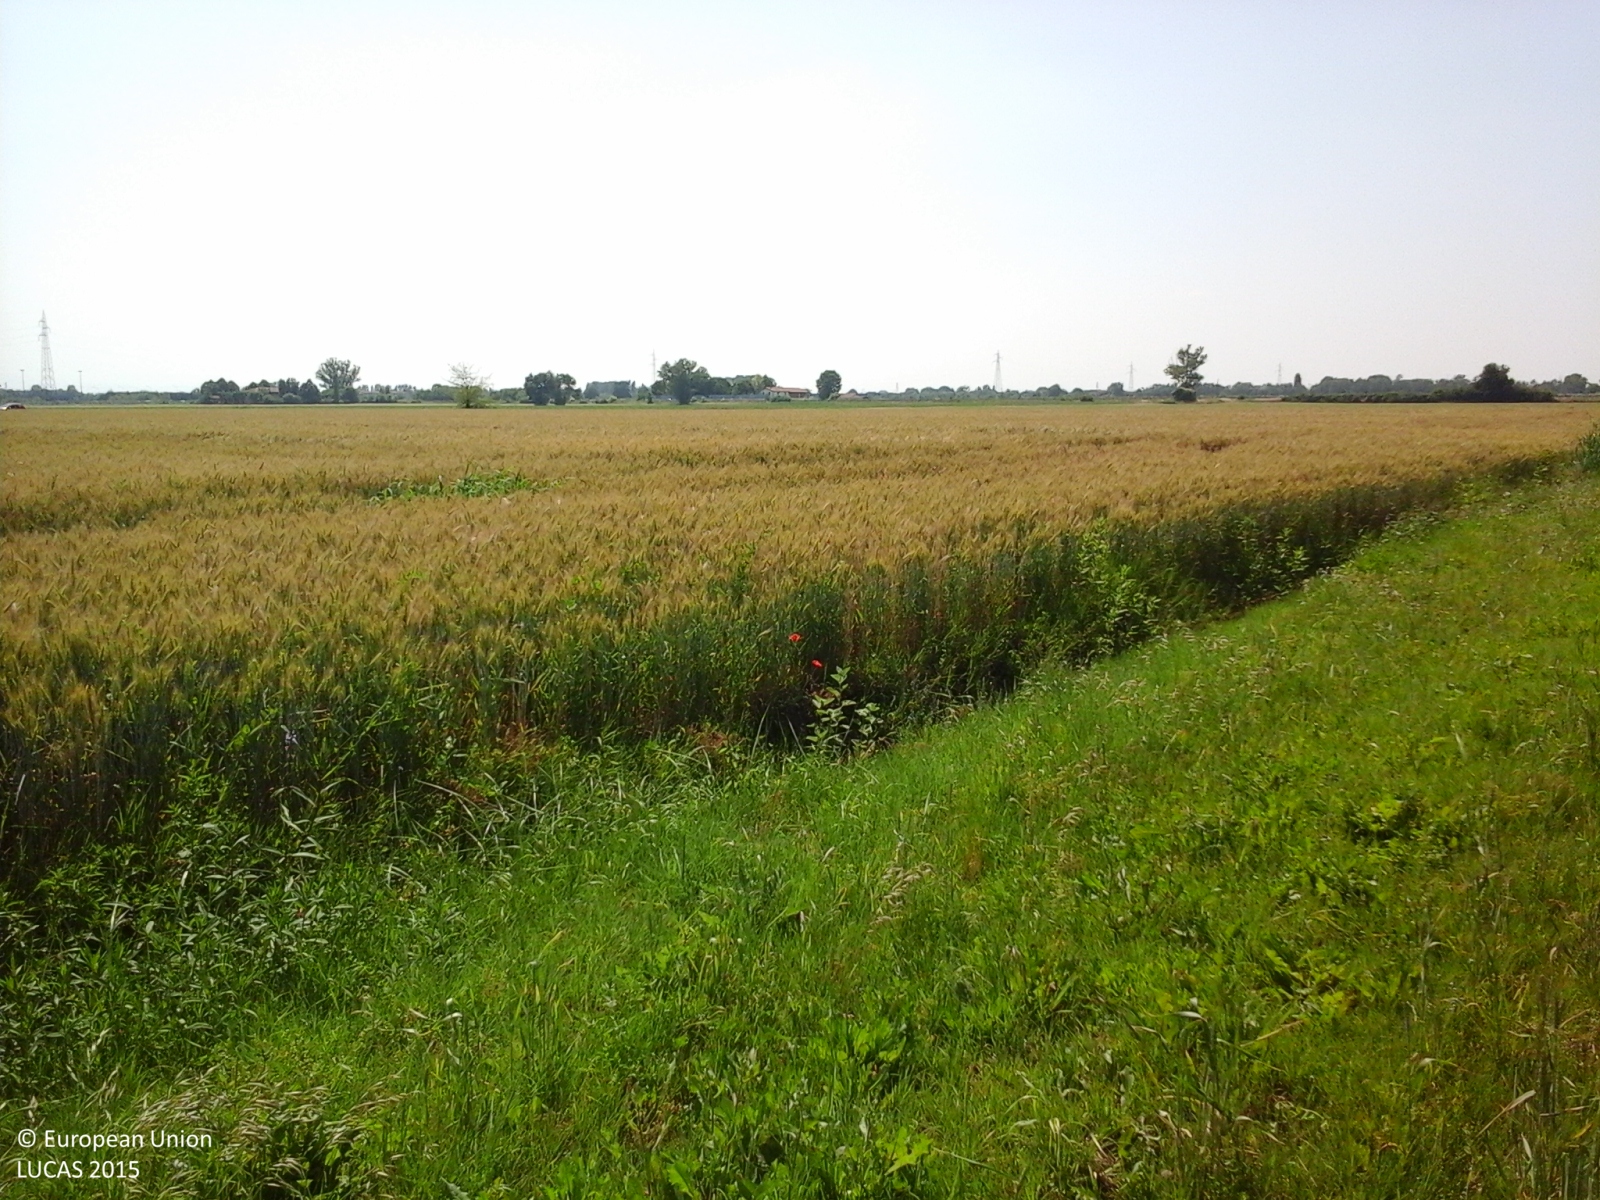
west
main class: Cropland
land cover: Common wheat
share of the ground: > 75 %
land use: Agriculture (excluding fallow land and kitchen gardens)
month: June
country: IT
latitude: 44.6683
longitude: 11.1958
